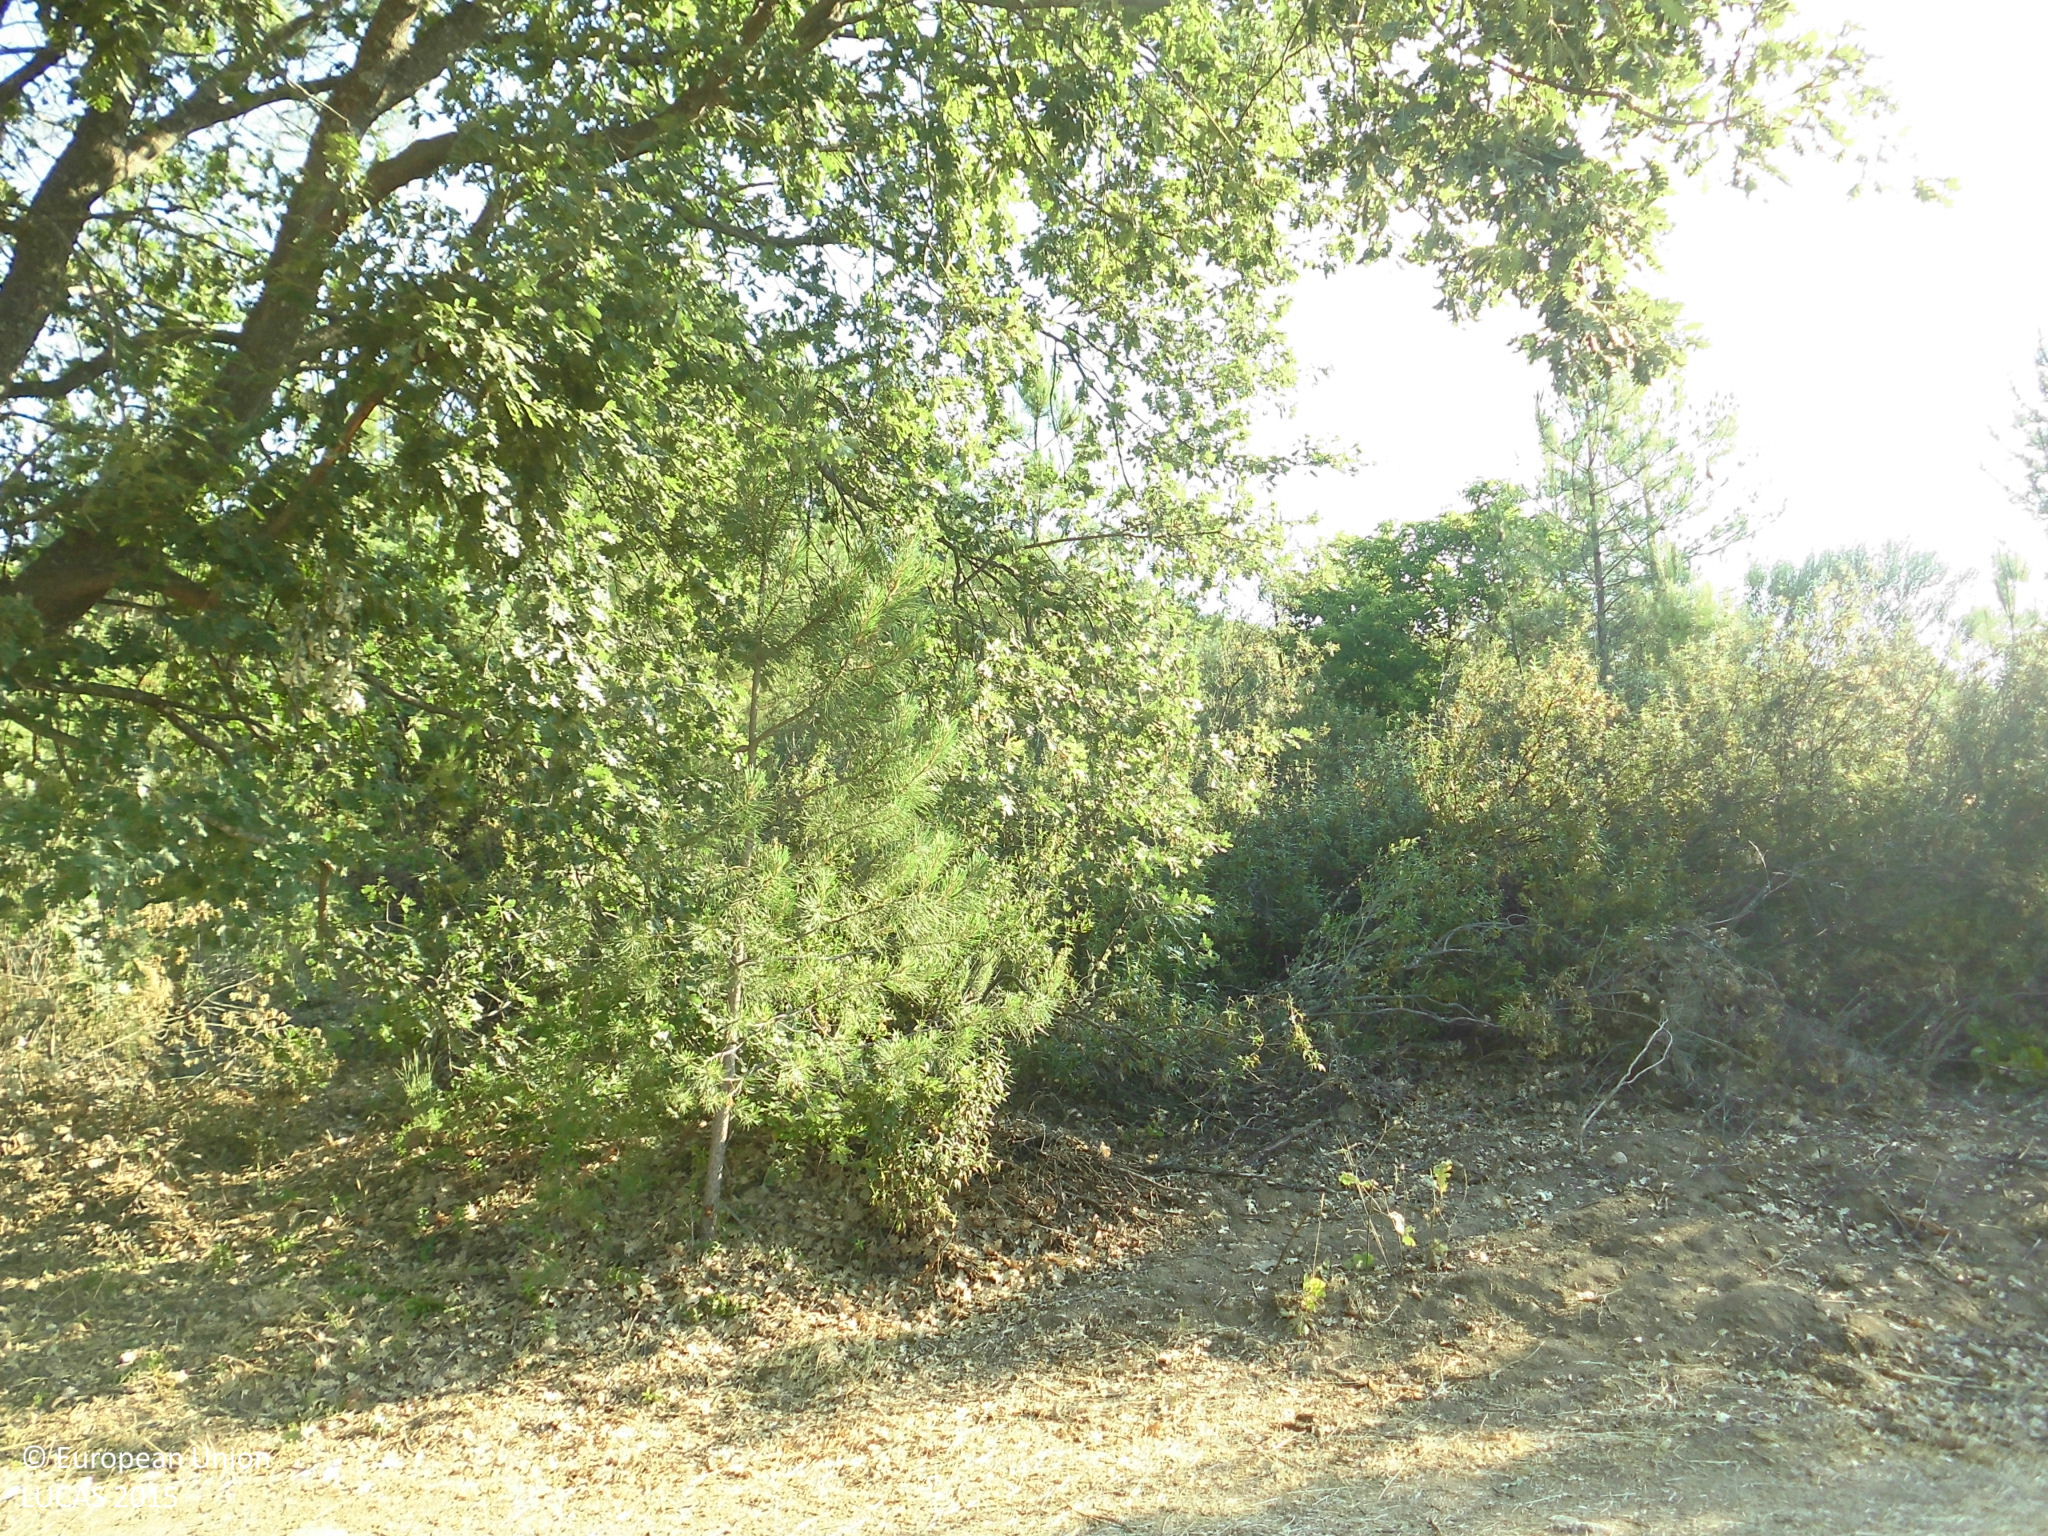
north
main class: Shrubland
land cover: Shrubland with sparse tree cover
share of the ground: > 75 %
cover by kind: shrubs 75 %, herbaceous plants 20 %, broadleaved forest trees 5 %
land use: Residential
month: June
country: ES
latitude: 40.1383
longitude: -5.4481
